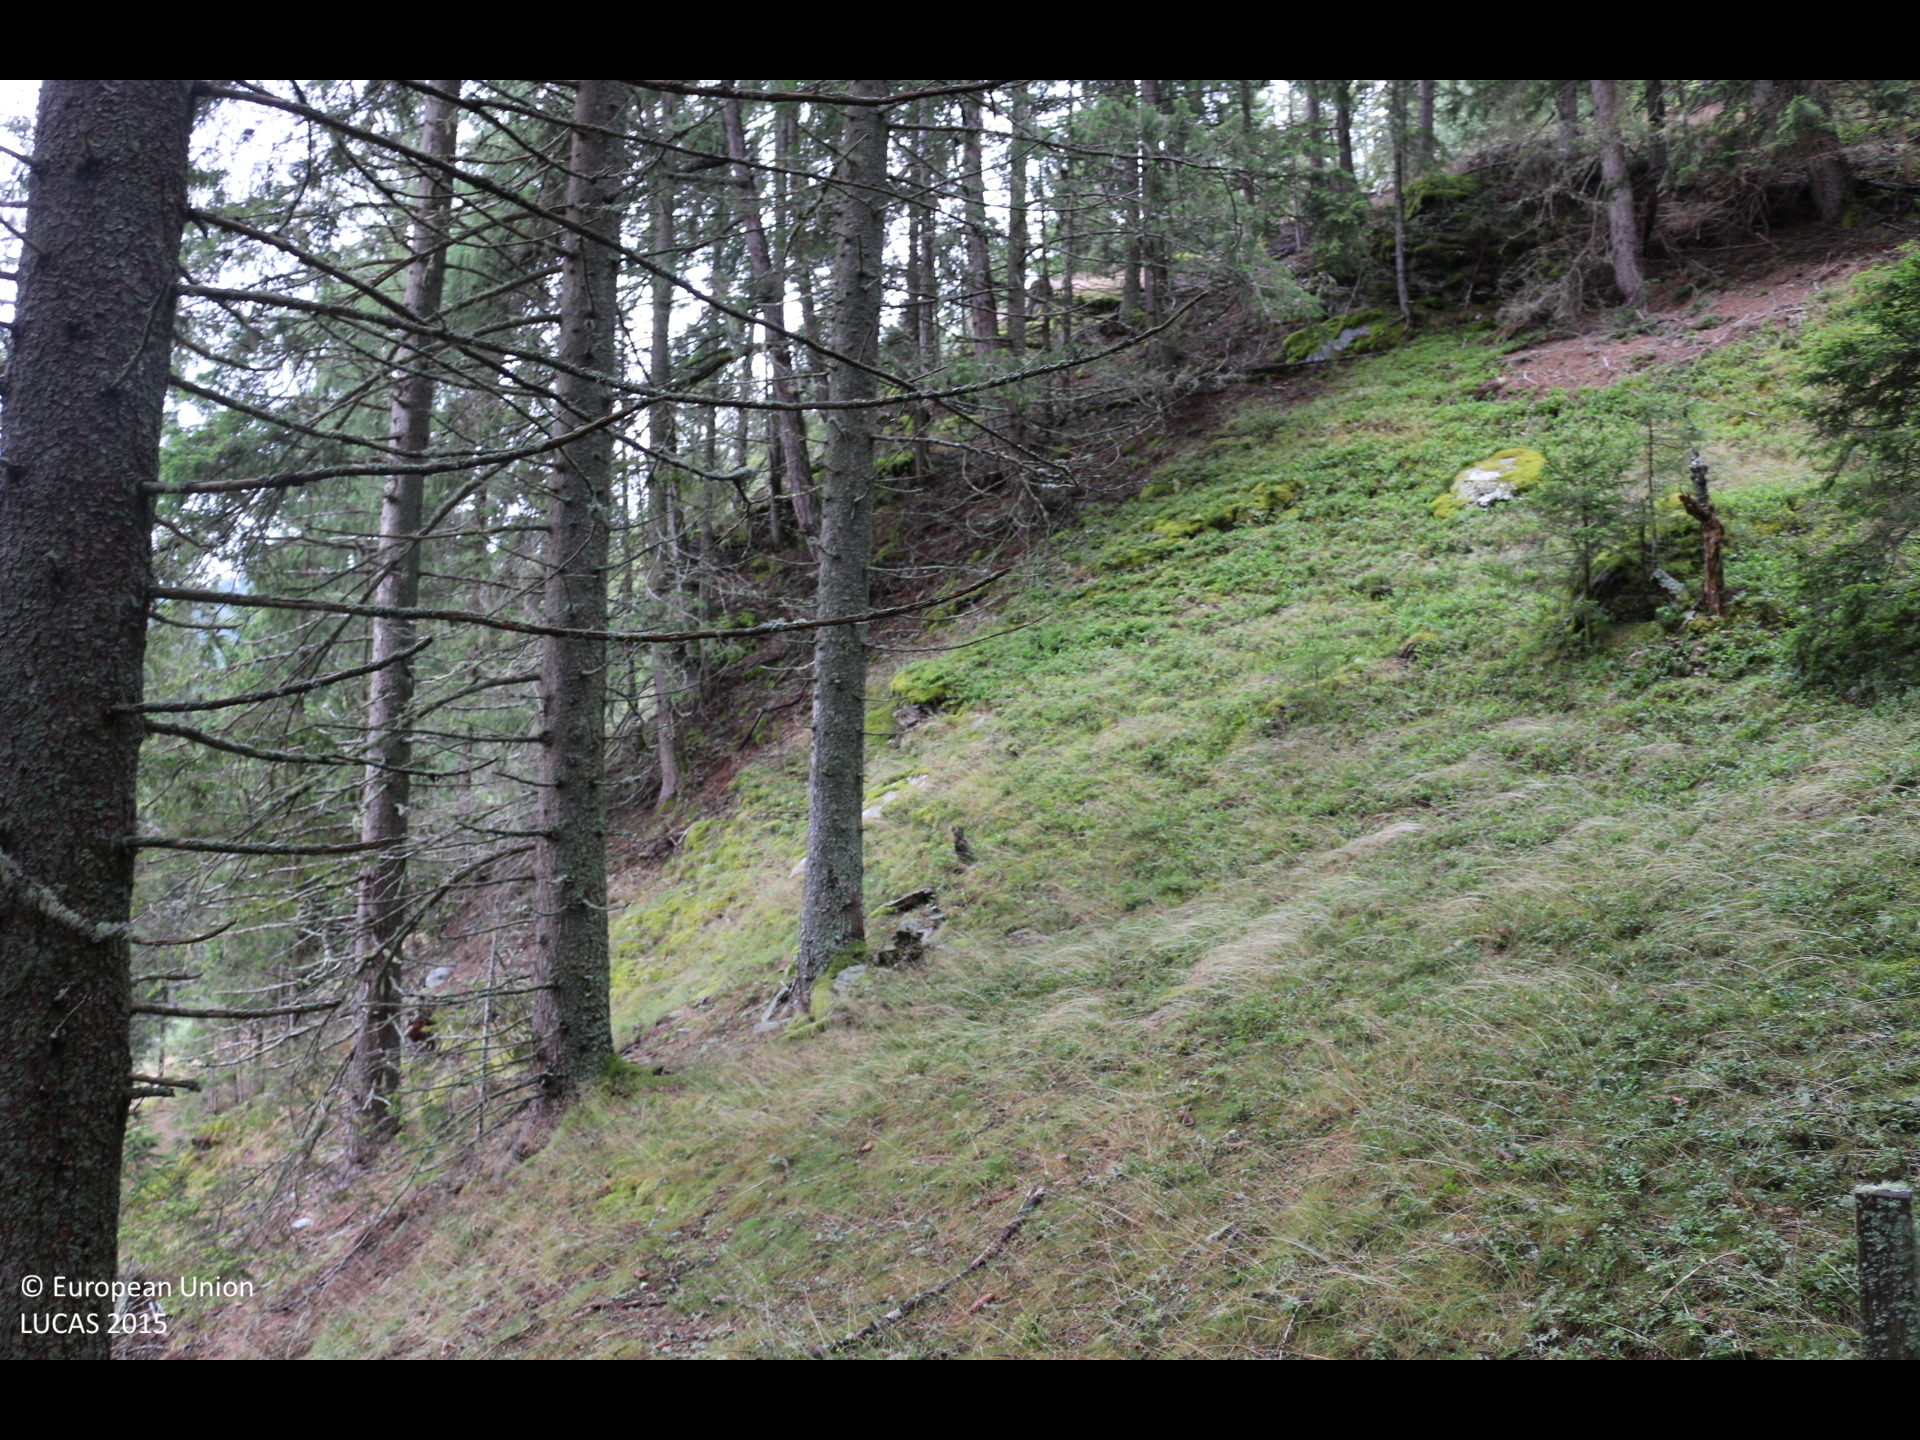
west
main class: Woodland
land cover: Spruce dominated coniferous woodland
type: alpine coniferous forest
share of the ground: > 75 %
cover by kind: coniferous forest trees 95 %, herbaceous plants 5 %
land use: Forestry
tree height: > 5 m
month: July
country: AT
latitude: 47.0242
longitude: 14.2478
